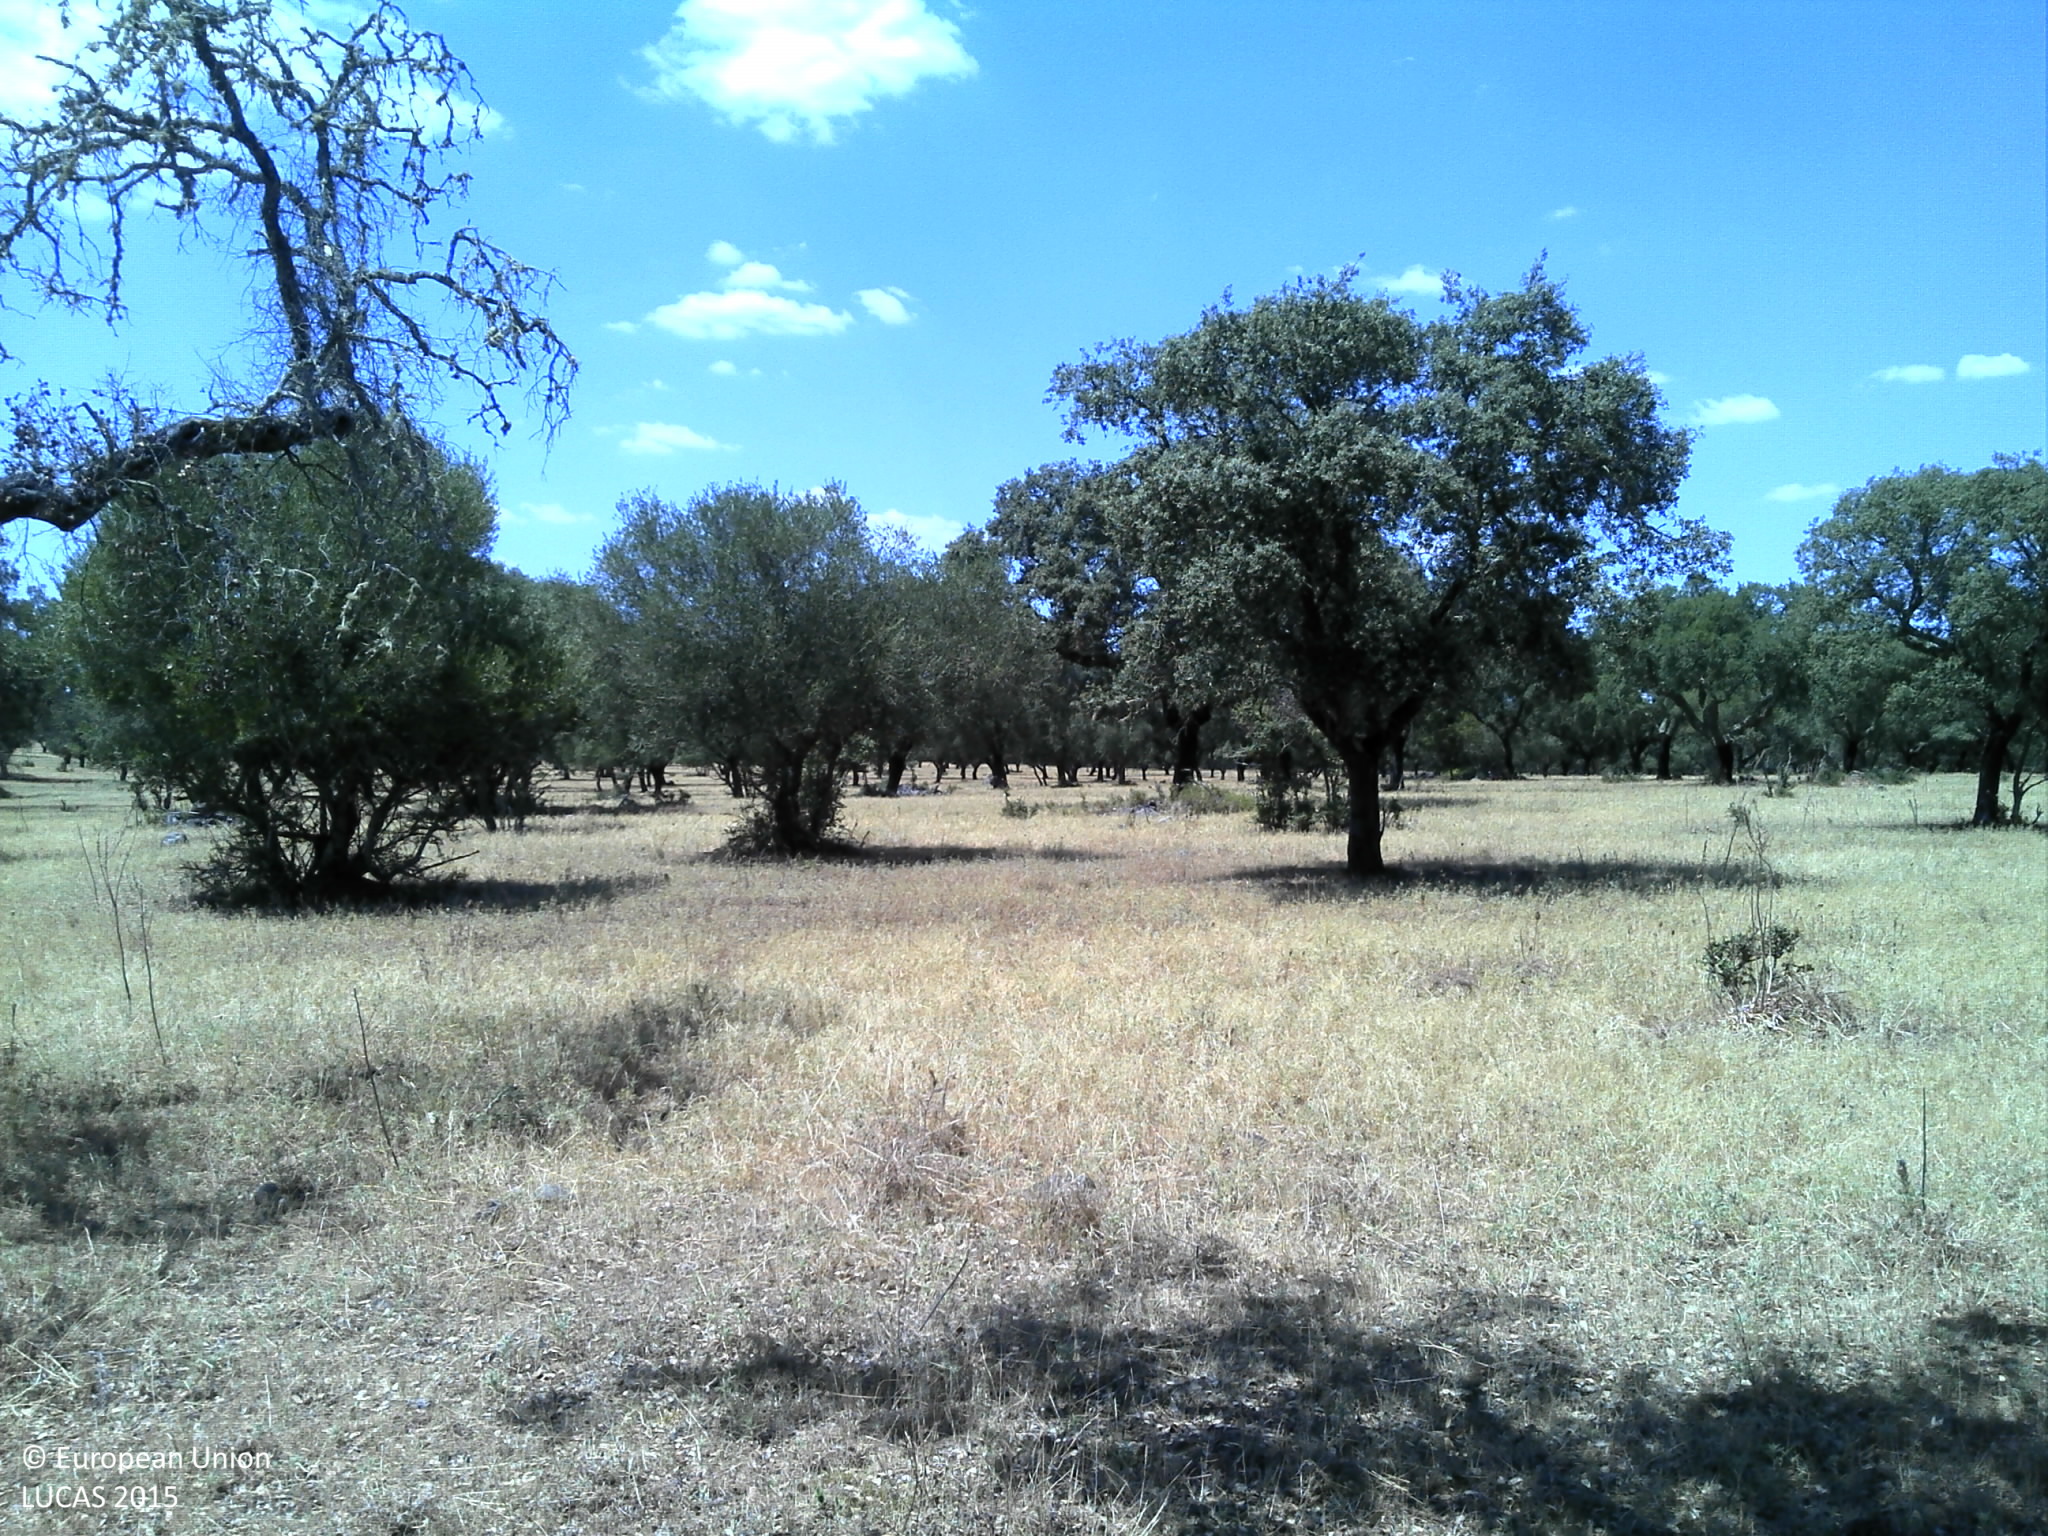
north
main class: Woodland
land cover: Broadleaved woodland
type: broadleaved evergreen forest
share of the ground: 10 - 25 %
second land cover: Grassland without tree/shrub cover
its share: 25 - 50 %
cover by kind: unconsolidated bare surface 50 %, broadleaved forest trees 25 %, herbaceous plants 25 %
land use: Forestry
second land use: Agriculture (excluding fallow land and kitchen gardens)
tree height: > 5 m
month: June
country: PT
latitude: 38.3537
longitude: -8.1560
